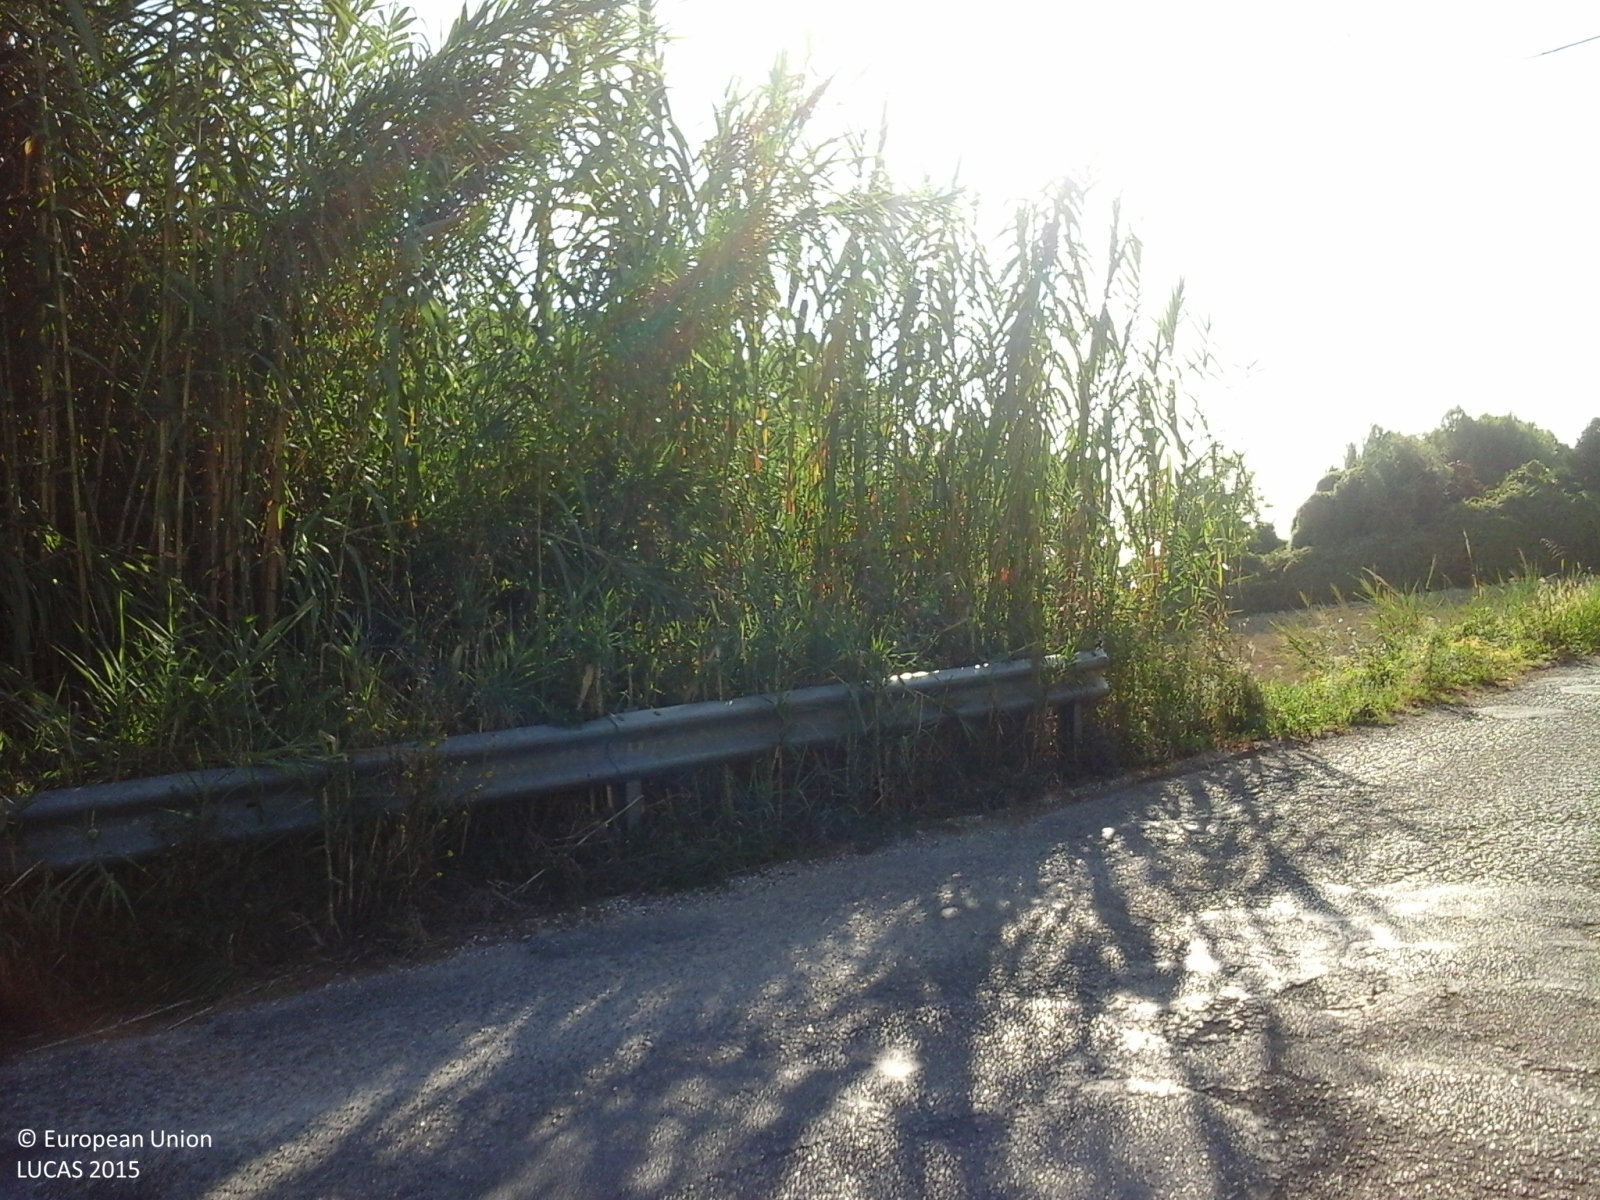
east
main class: Cropland
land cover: Durum wheat
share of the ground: < 10 %
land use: Agriculture (excluding fallow land and kitchen gardens)
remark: Harvested field
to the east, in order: Durum wheat; Vineyards; Managed hedges; Fences; Paved roads, cycling and walking lanes; Electric lines; Artificial constructions; Grassland with sparse tree/shrub cover; Artificial constructions; Broadleaved woodland; Artificial constructions in urban areas
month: September
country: IT
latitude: 43.8749
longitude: 12.9674
